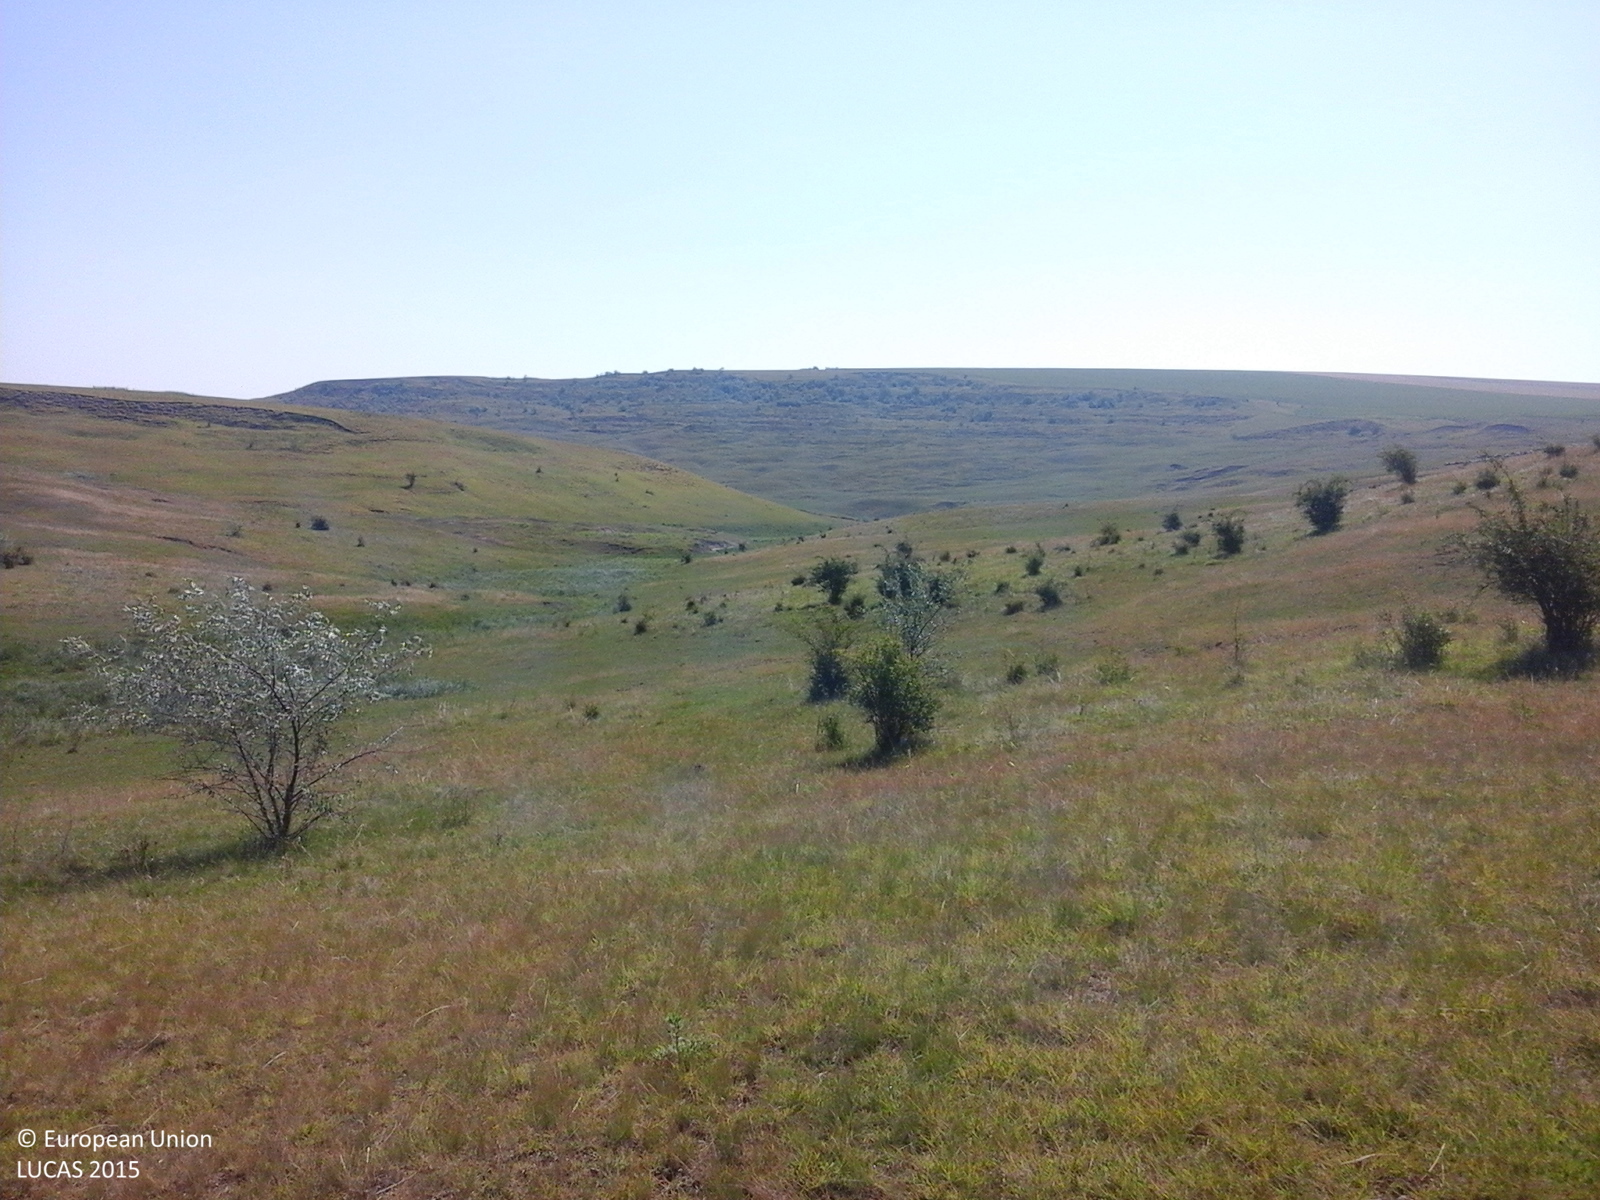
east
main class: Grassland
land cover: Grassland with sparse tree/shrub cover
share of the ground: > 75 %
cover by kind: herbaceous plants 85 %, shrubs 10 %, broadleaved forest trees 5 %
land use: Agriculture (excluding fallow land and kitchen gardens)
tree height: < 5 m
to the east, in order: Grassland with sparse tree/shrub cover; Grassland without tree/shrub cover; Grassland with sparse tree/shrub cover; Grassland without tree/shrub cover; Grassland with sparse tree/shrub cover
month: June
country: RO
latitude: 47.6854
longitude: 27.2026
